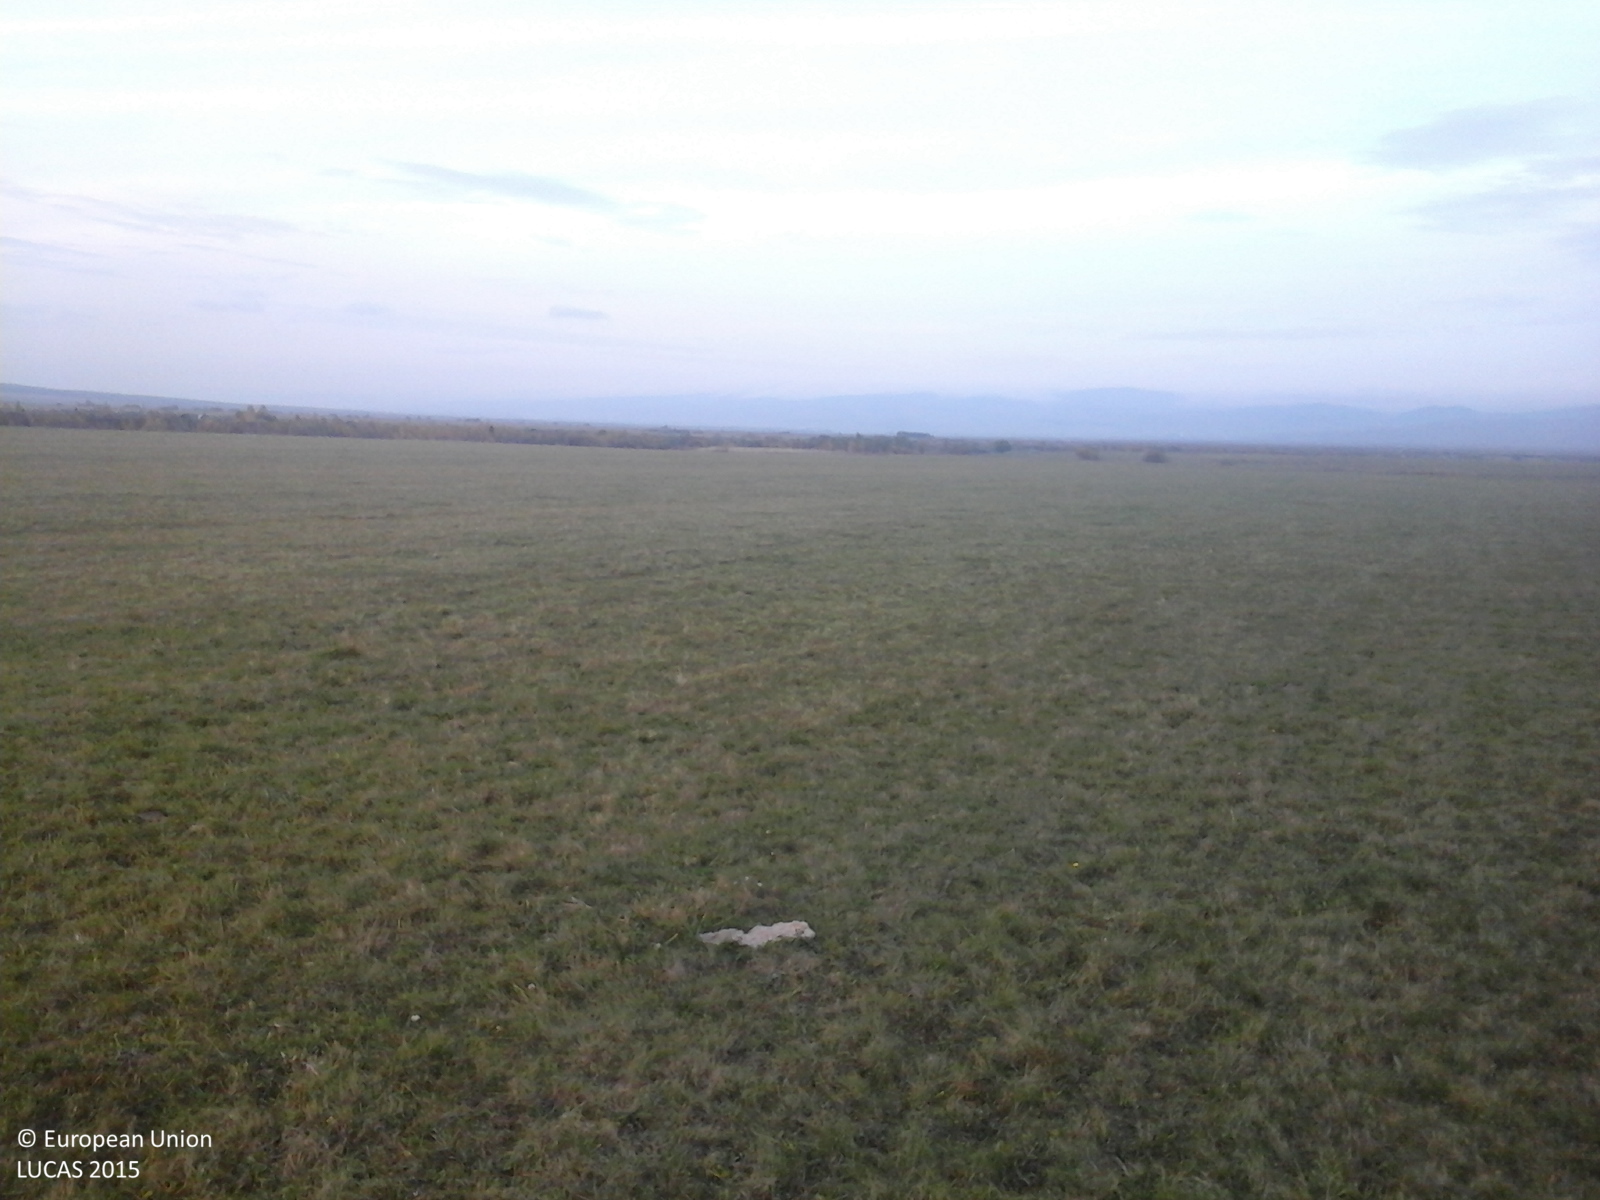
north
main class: Grassland
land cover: Grassland without tree/shrub cover
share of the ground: > 75 %
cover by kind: herbaceous plants 100 %
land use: Agriculture (excluding fallow land and kitchen gardens)
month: October
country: RO
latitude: 46.7079
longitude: 25.4255
